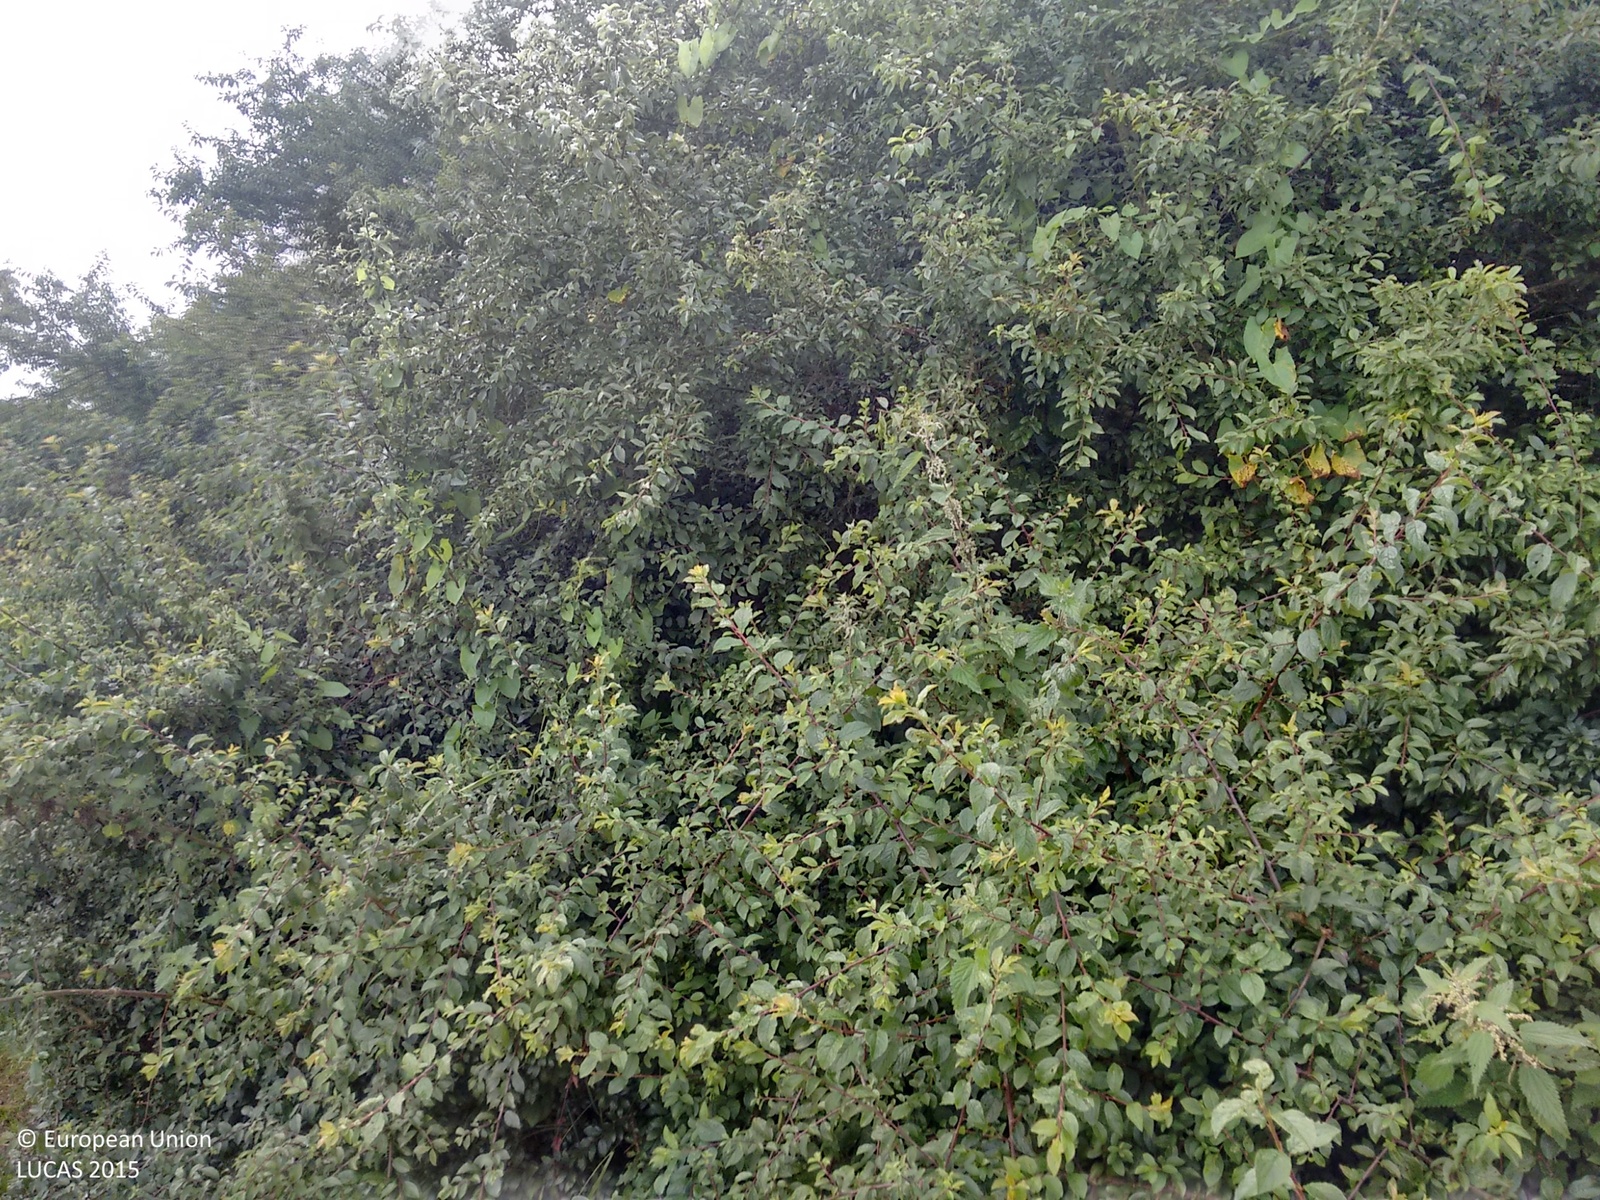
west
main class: Woodland
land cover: Broadleaved woodland
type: mesophytic deciduous forest
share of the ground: > 75 %
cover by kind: broadleaved forest trees 100 %
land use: Agriculture (excluding fallow land and kitchen gardens)
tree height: > 5 m
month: August
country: GB
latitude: 50.0655
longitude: -5.2509
